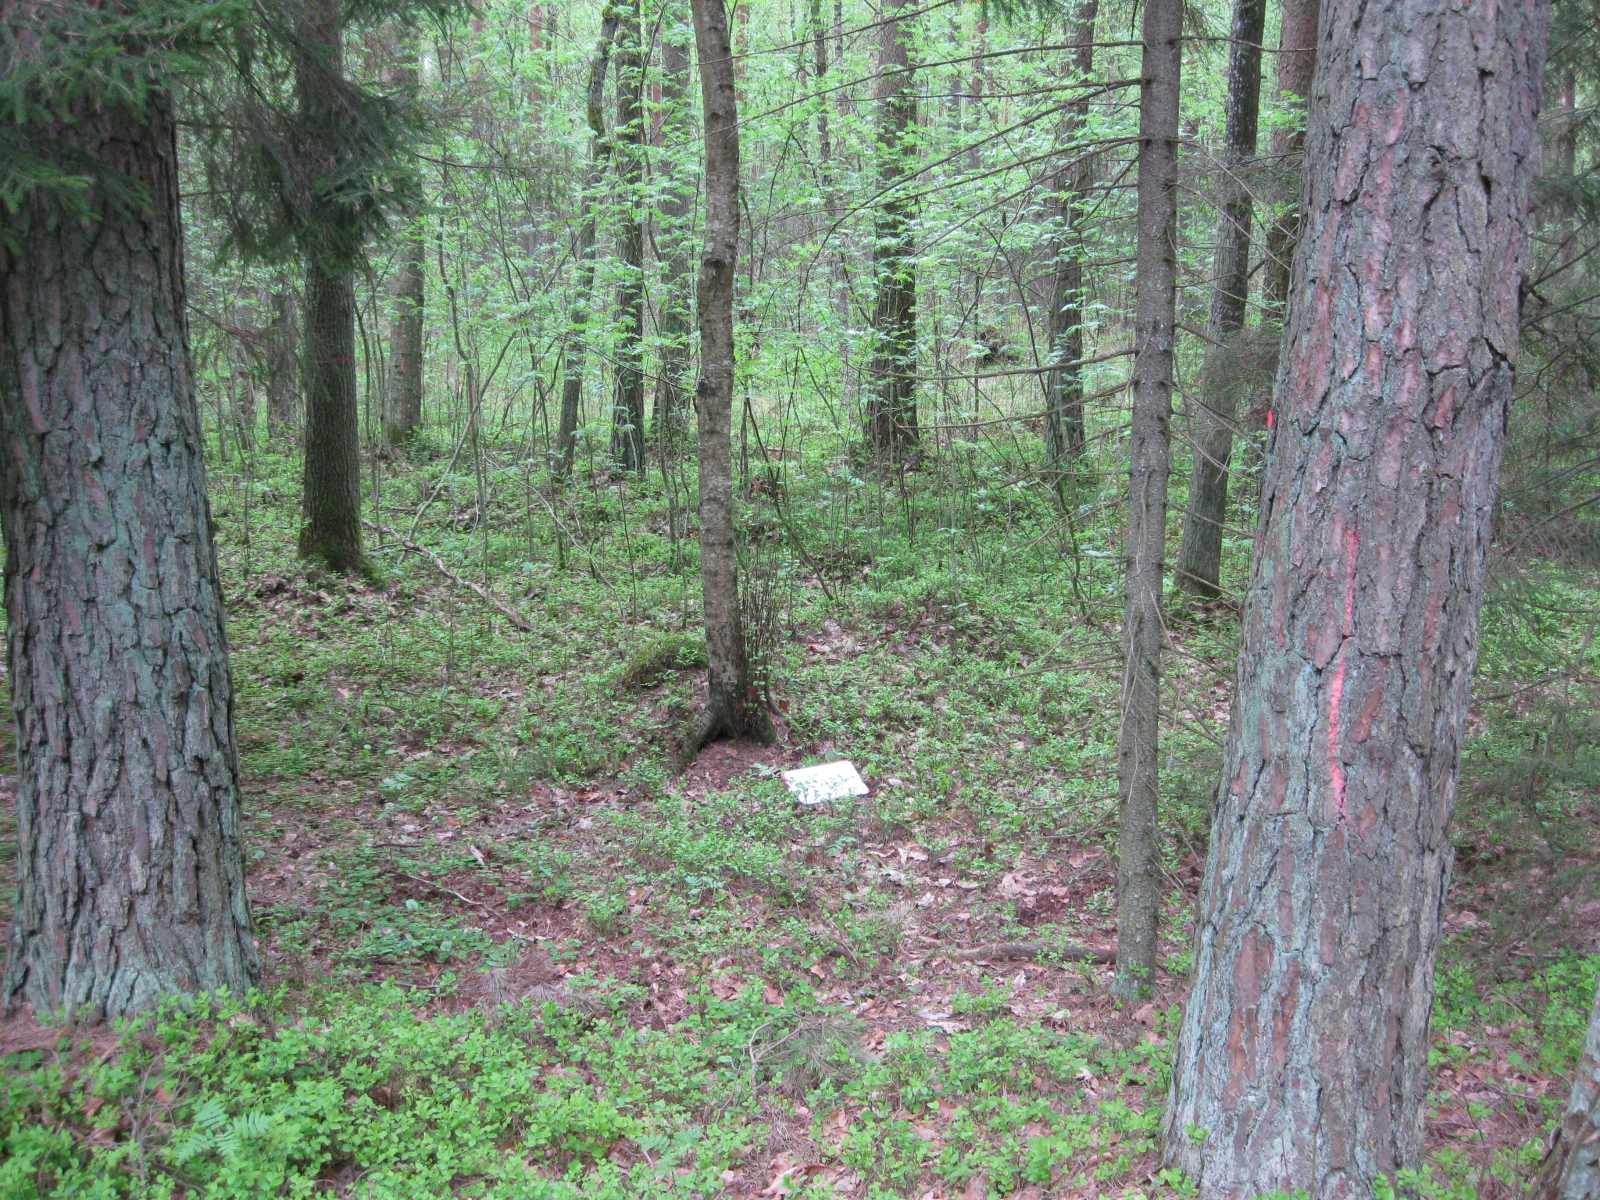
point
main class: Woodland
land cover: Other mixed woodland
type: hemiboreal forest and nemoral coniferous forest and mixed broadleaved-coniferous forest
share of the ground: > 75 %
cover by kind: coniferous forest trees 45 %, broadleaved forest trees 40 %, shrubs 5 %, herbaceous plants 5 %, lichens and mosses 5 %
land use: Forestry
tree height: > 5 m
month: May
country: LT
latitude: 55.9588
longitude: 24.3671
